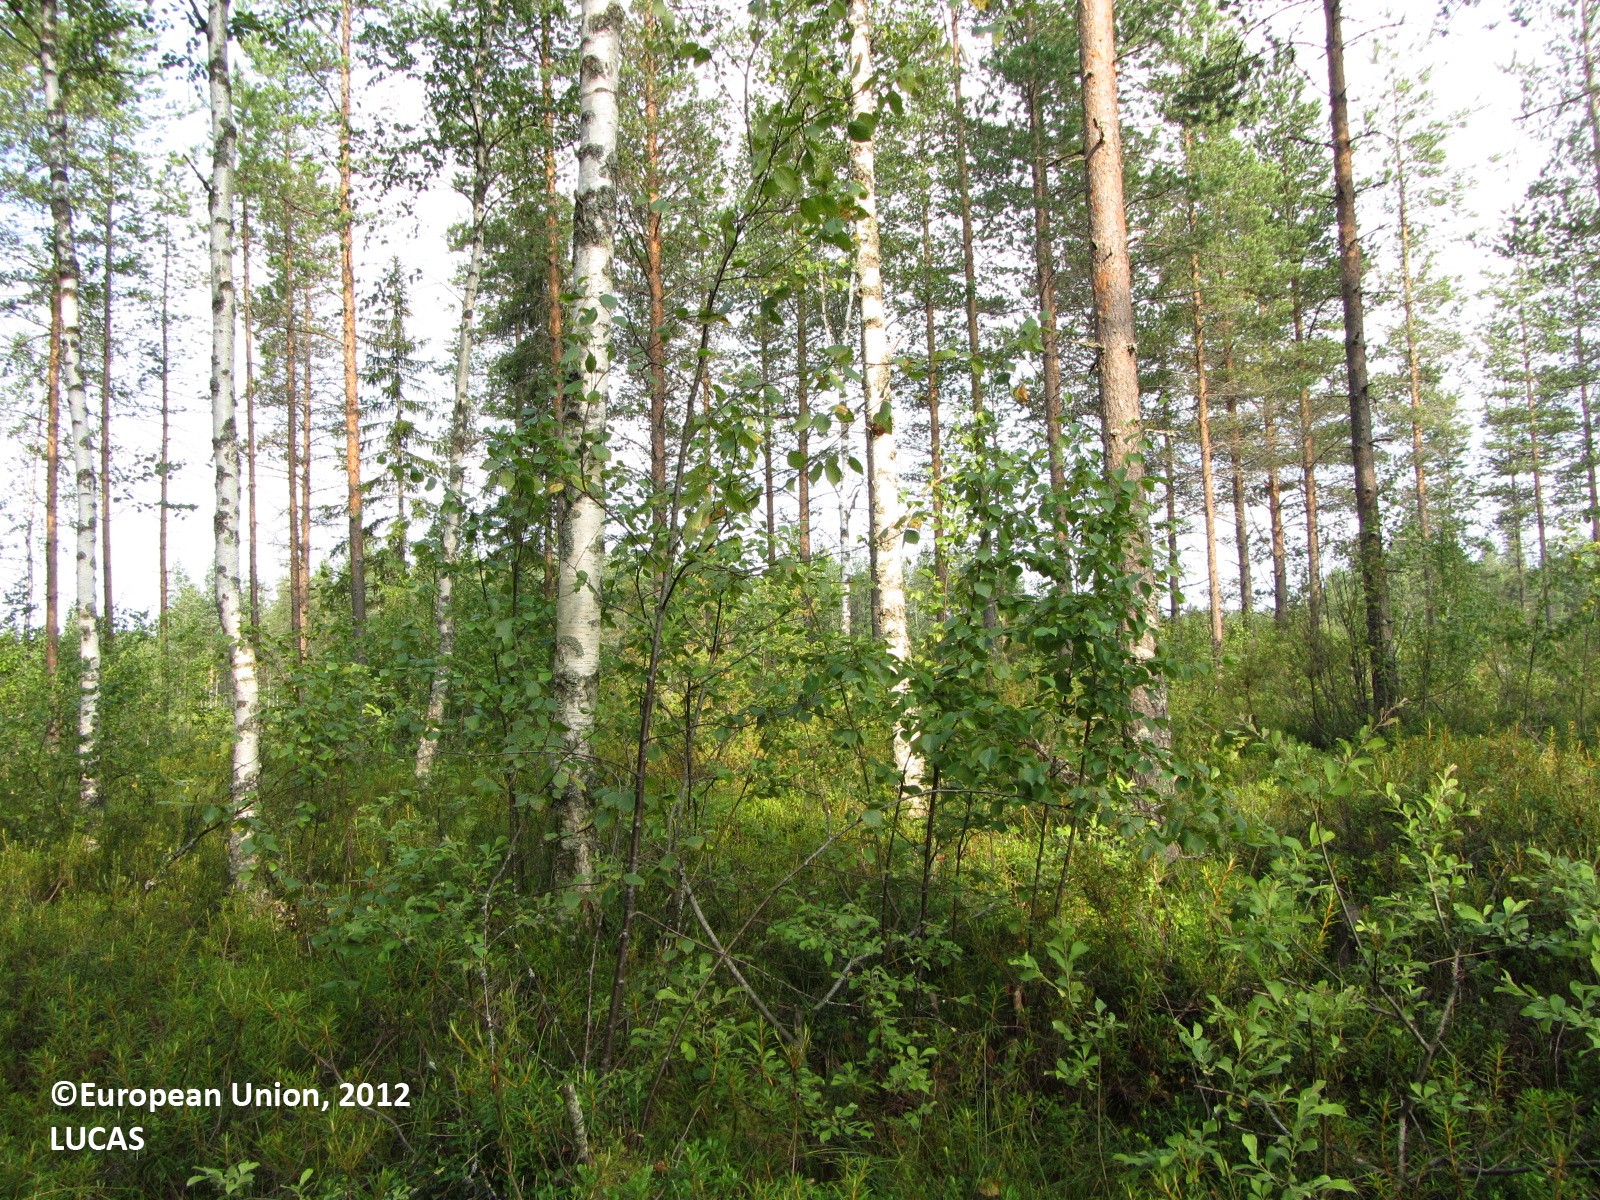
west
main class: Woodland
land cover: Pine dominated mixed woodland
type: boreal forest
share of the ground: 50 - 75 %
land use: Forestry
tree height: > 5 m
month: July
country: FI
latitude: 63.5742
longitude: 24.5611
